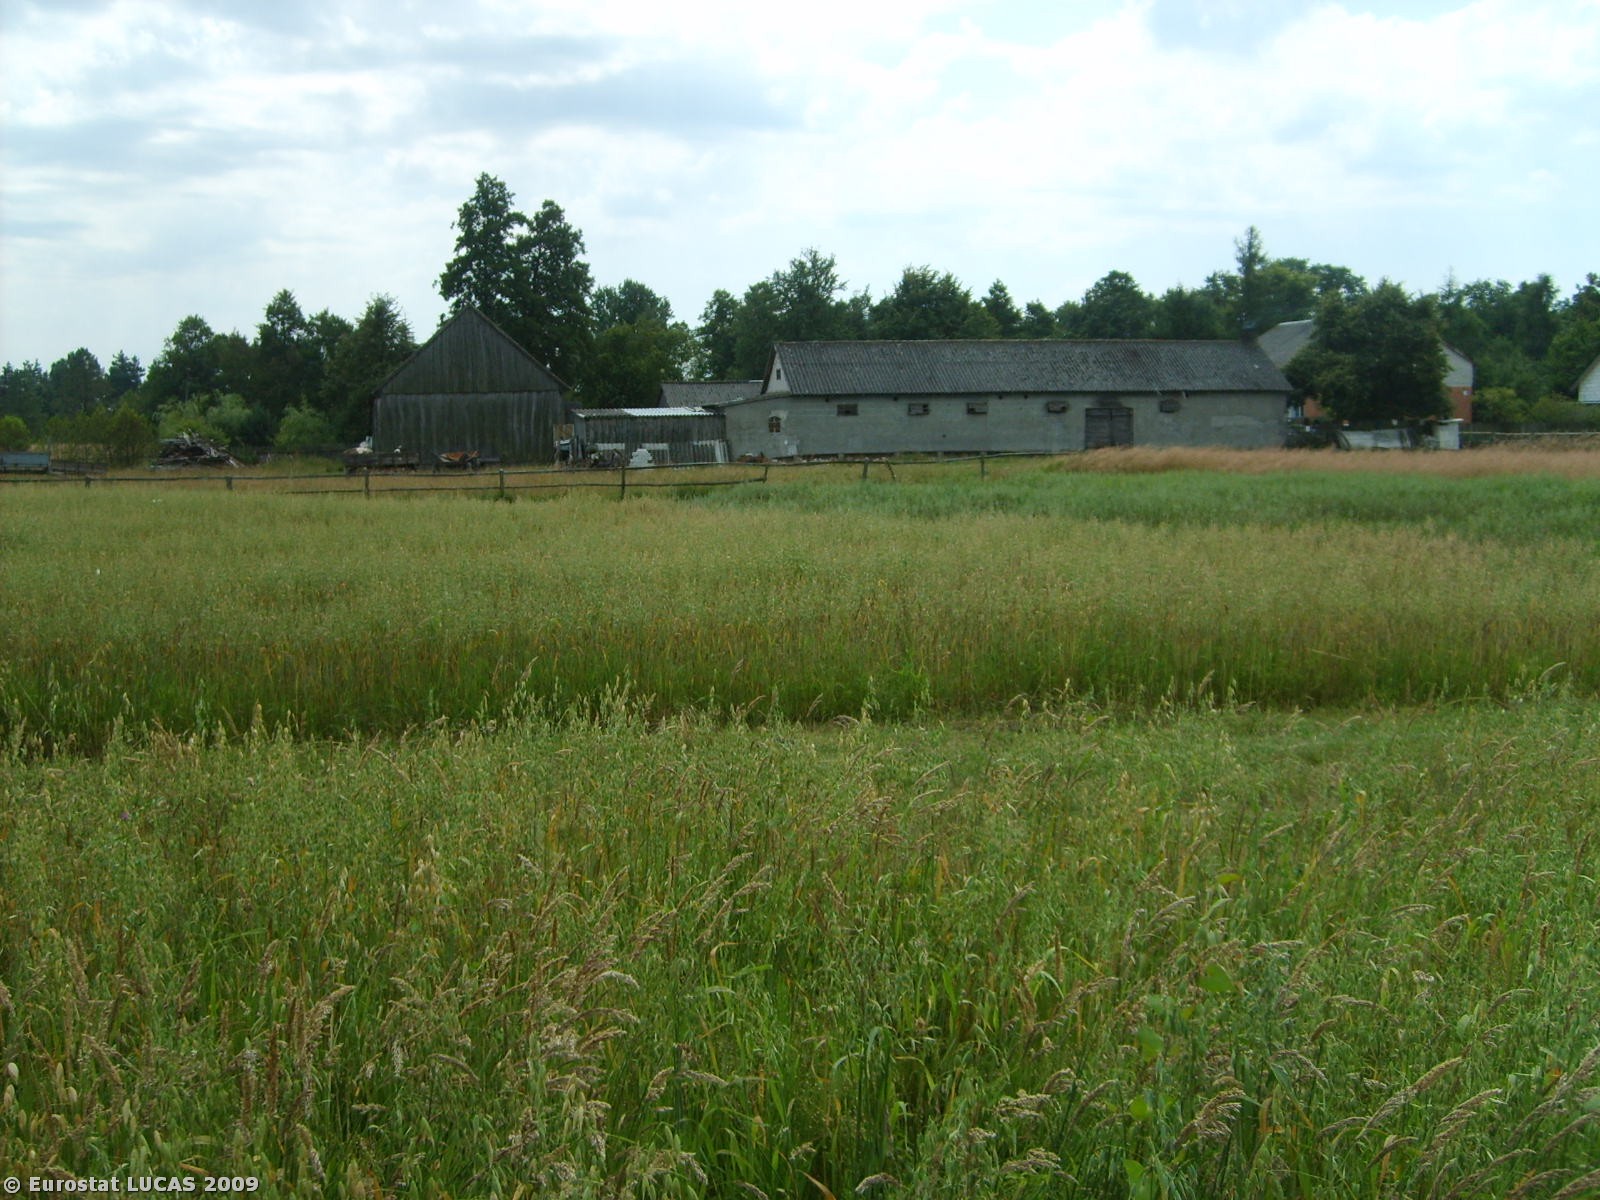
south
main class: Cropland
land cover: Oats
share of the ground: > 75 %
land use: Agriculture (excluding fallow land and kitchen gardens)
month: July
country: PL
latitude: 52.4544
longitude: 21.6638
